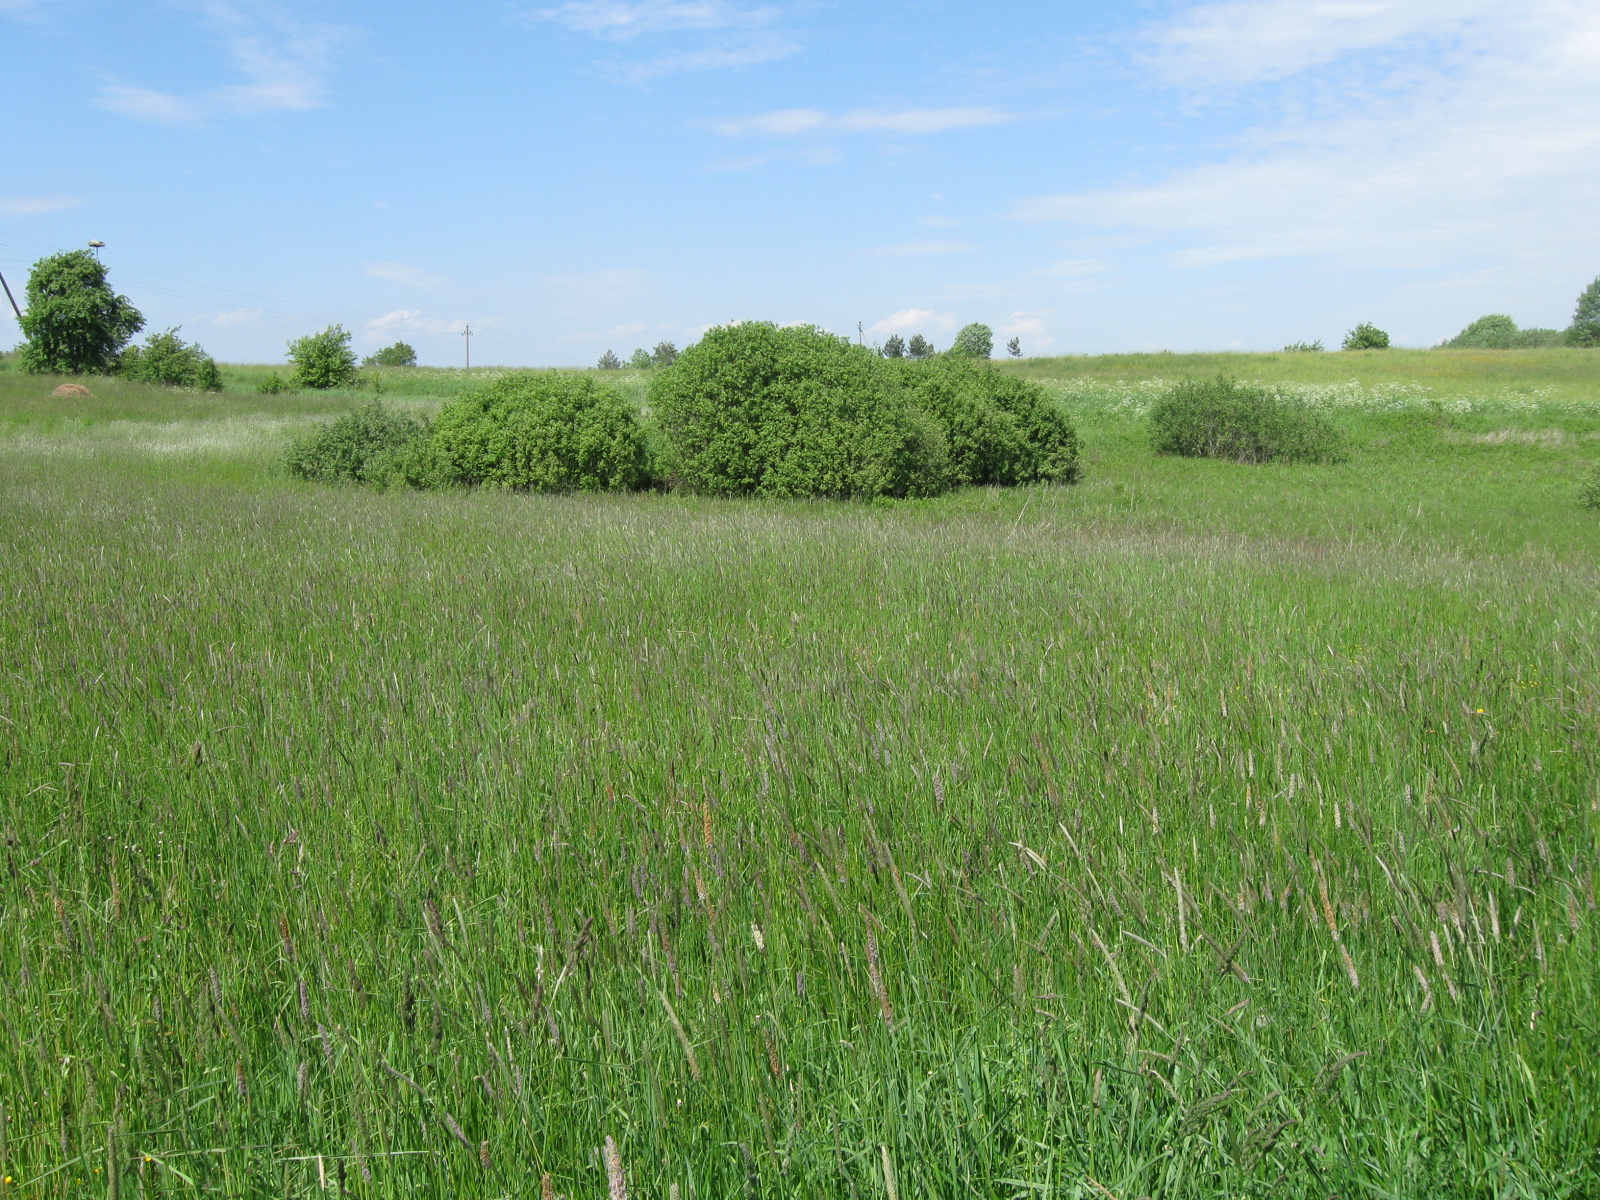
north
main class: Grassland
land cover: Grassland without tree/shrub cover
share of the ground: > 75 %
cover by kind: herbaceous plants 100 %
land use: Agriculture (excluding fallow land and kitchen gardens)
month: June
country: LT
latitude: 54.2330
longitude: 23.7882
